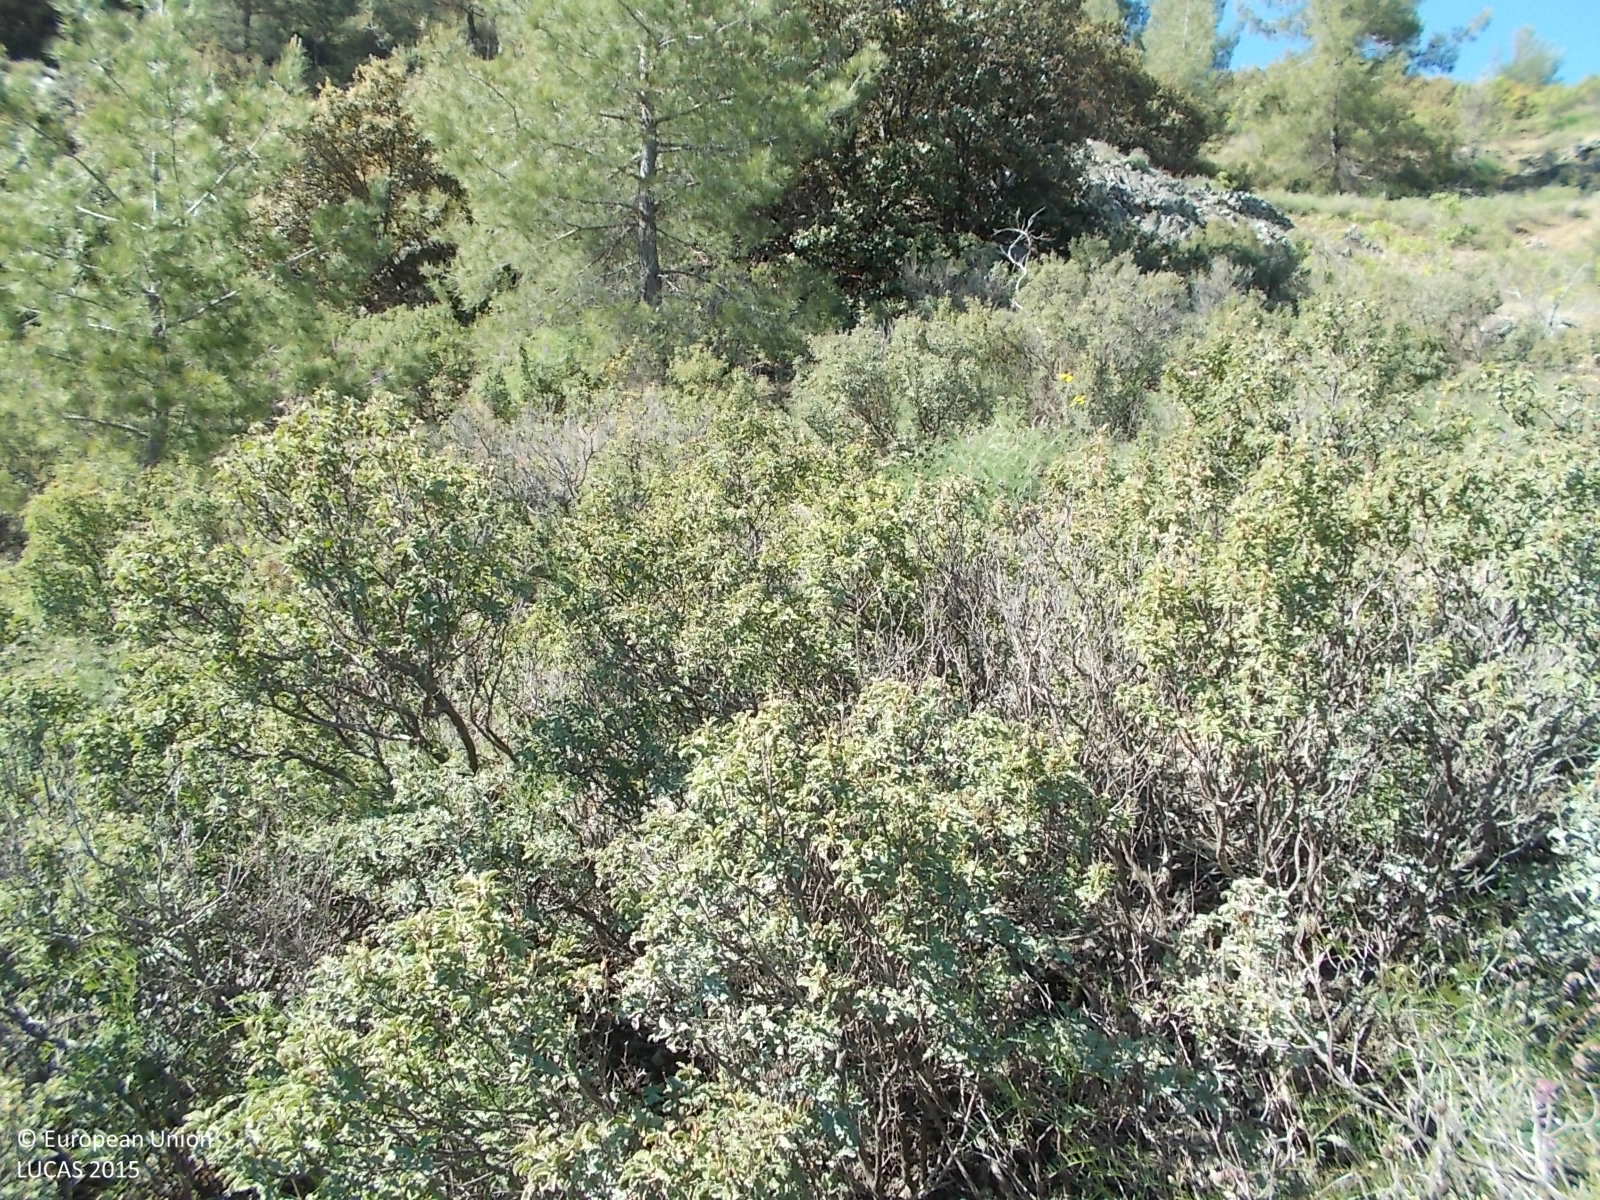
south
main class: Shrubland
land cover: Shrubland with sparse tree cover
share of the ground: > 75 %
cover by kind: shrubs 95 %, broadleaved forest trees 5 %
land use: Semi-natural and natural areas not in use
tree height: < 5 m
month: May
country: CY
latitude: 34.8810
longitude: 33.0265
